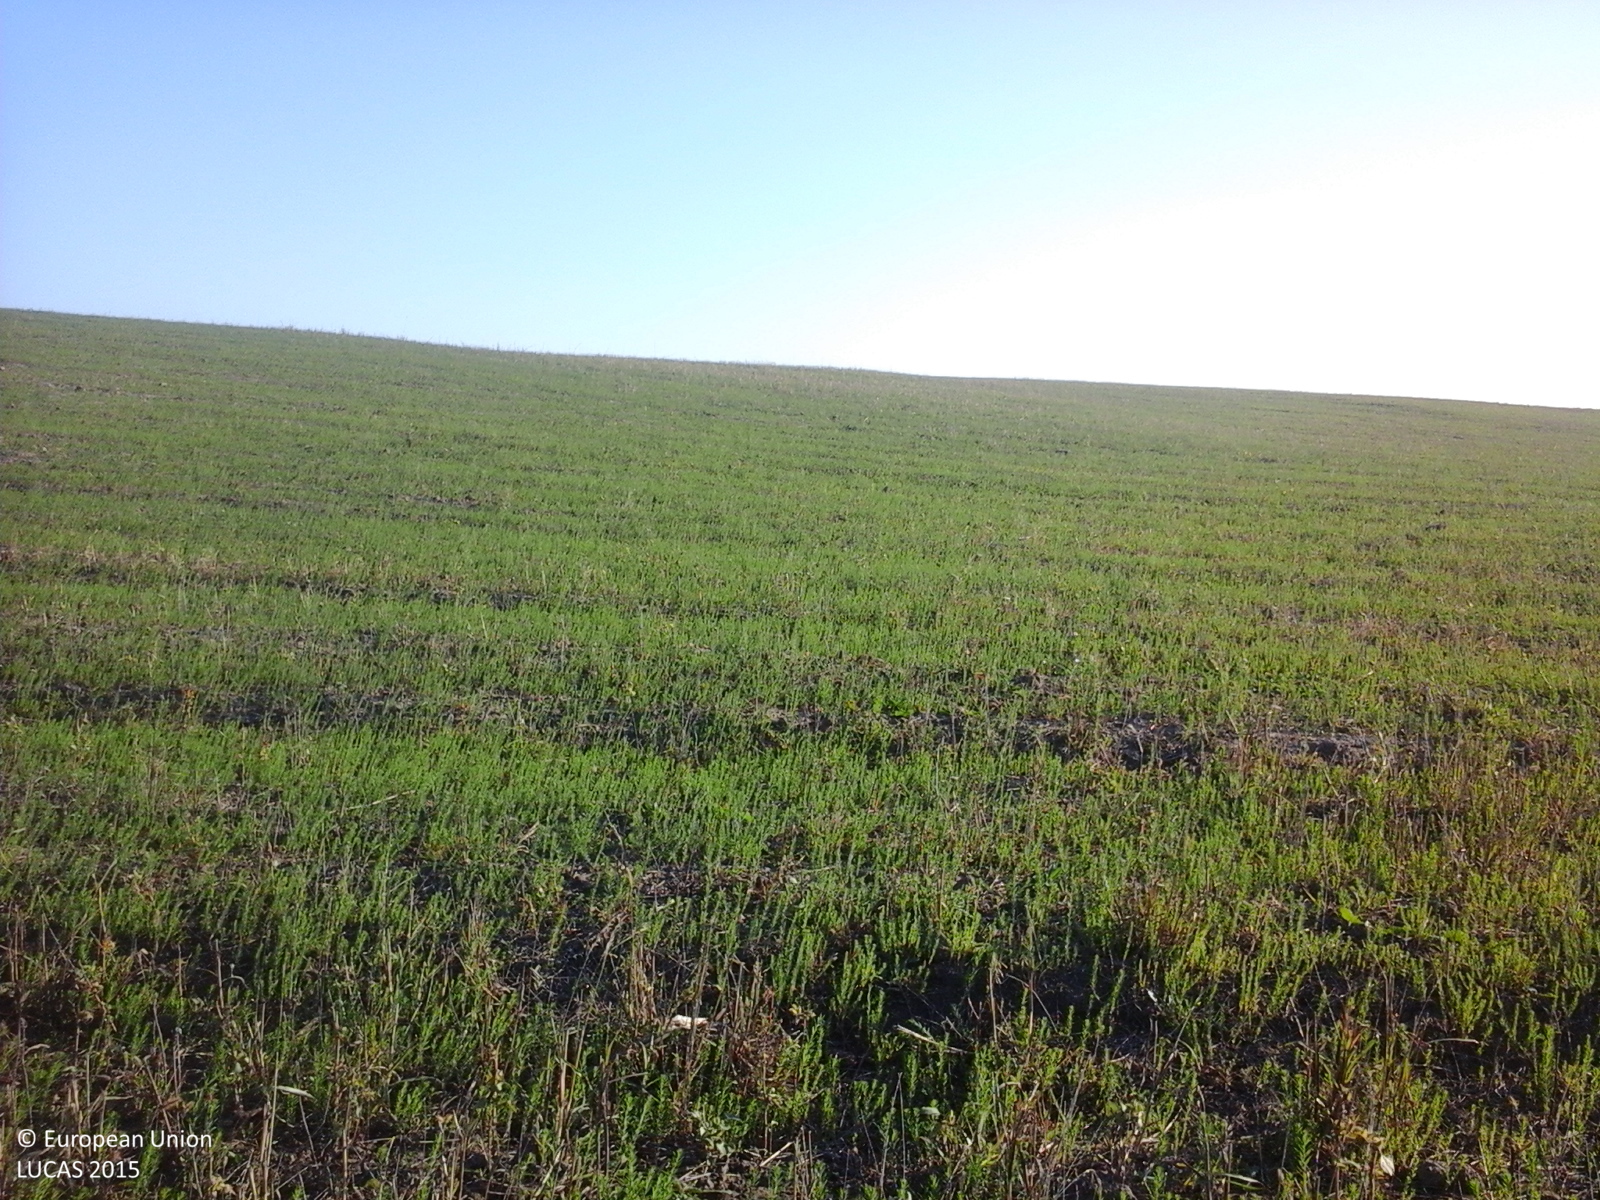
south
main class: Cropland
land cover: Temporary grasslands
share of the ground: > 75 %
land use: Agriculture (excluding fallow land and kitchen gardens)
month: October
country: RO
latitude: 45.3753
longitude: 27.3746
